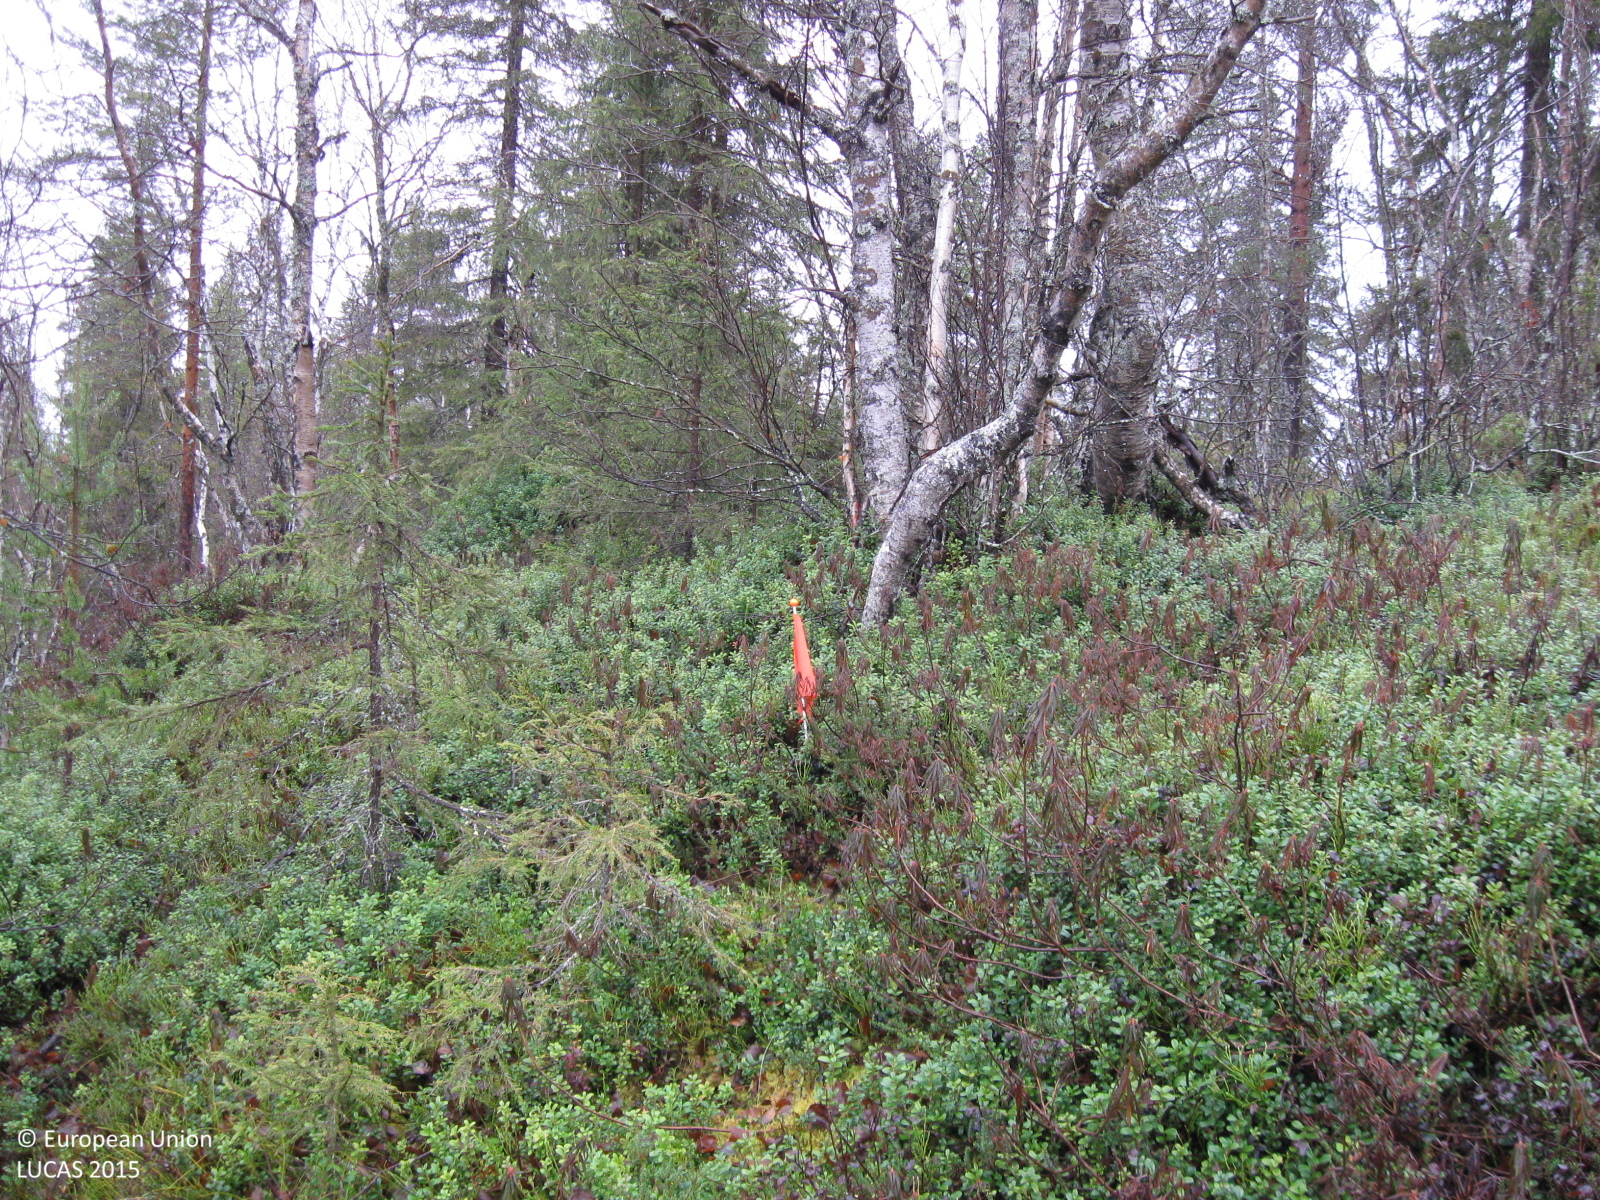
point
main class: Woodland
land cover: Spruce dominated mixed woodland
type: boreal forest
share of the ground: 50 - 75 %
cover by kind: shrubs 35 %, broadleaved forest trees 30 %, coniferous forest trees 20 %, herbaceous plants 10 %, lichens and mosses 5 %
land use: Forestry
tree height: > 5 m
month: October
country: SE
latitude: 66.5410
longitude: 20.9662
